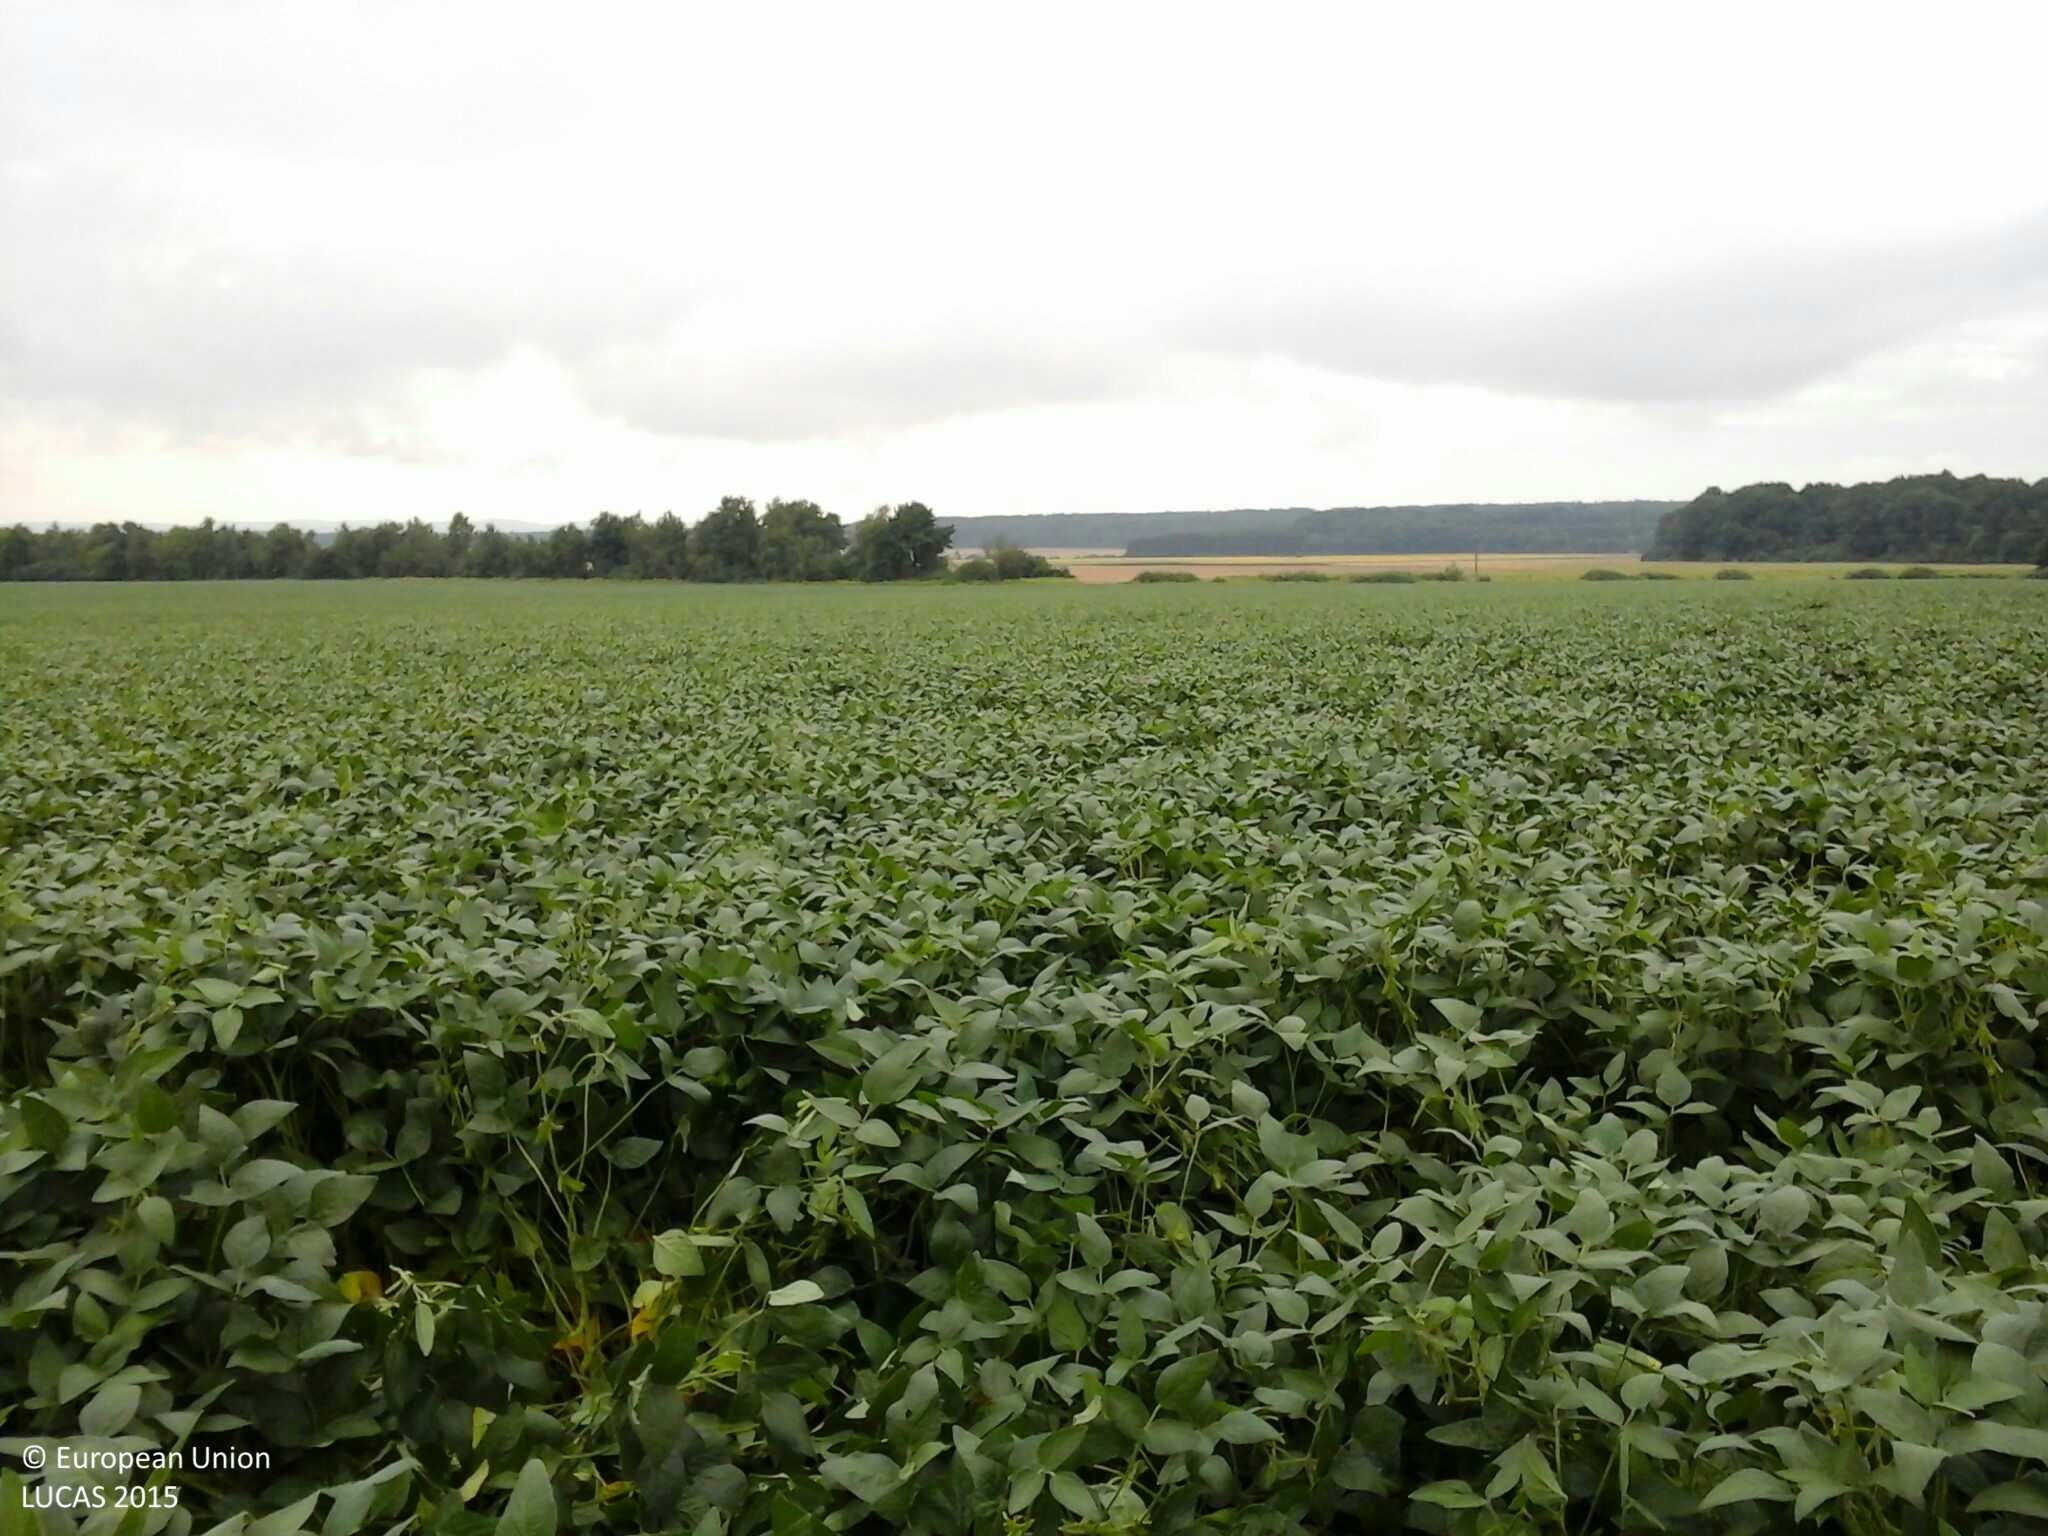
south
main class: Cropland
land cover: Soya
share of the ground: > 75 %
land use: Agriculture (excluding fallow land and kitchen gardens)
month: July
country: HU
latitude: 46.7180
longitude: 16.4250
